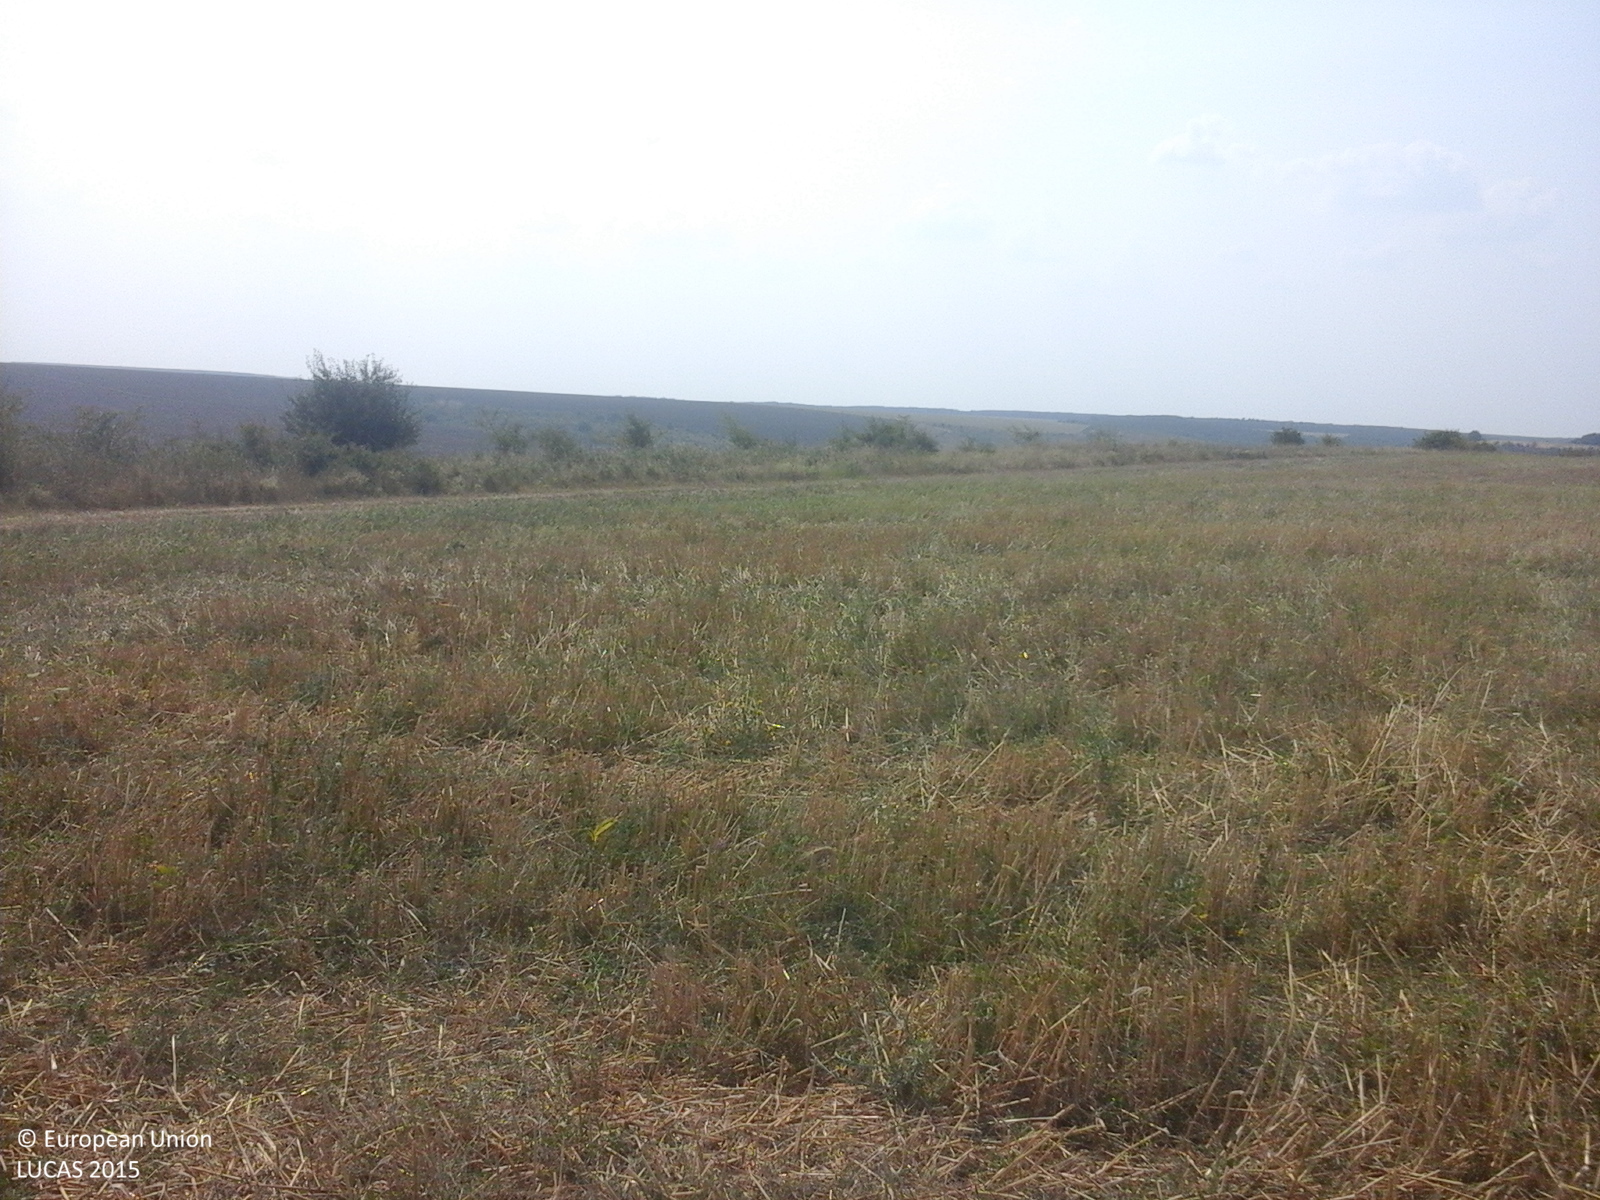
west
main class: Cropland
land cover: Durum wheat
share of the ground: 25 - 50 %
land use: Agriculture (excluding fallow land and kitchen gardens)
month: August
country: RO
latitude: 44.2389
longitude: 23.7154
